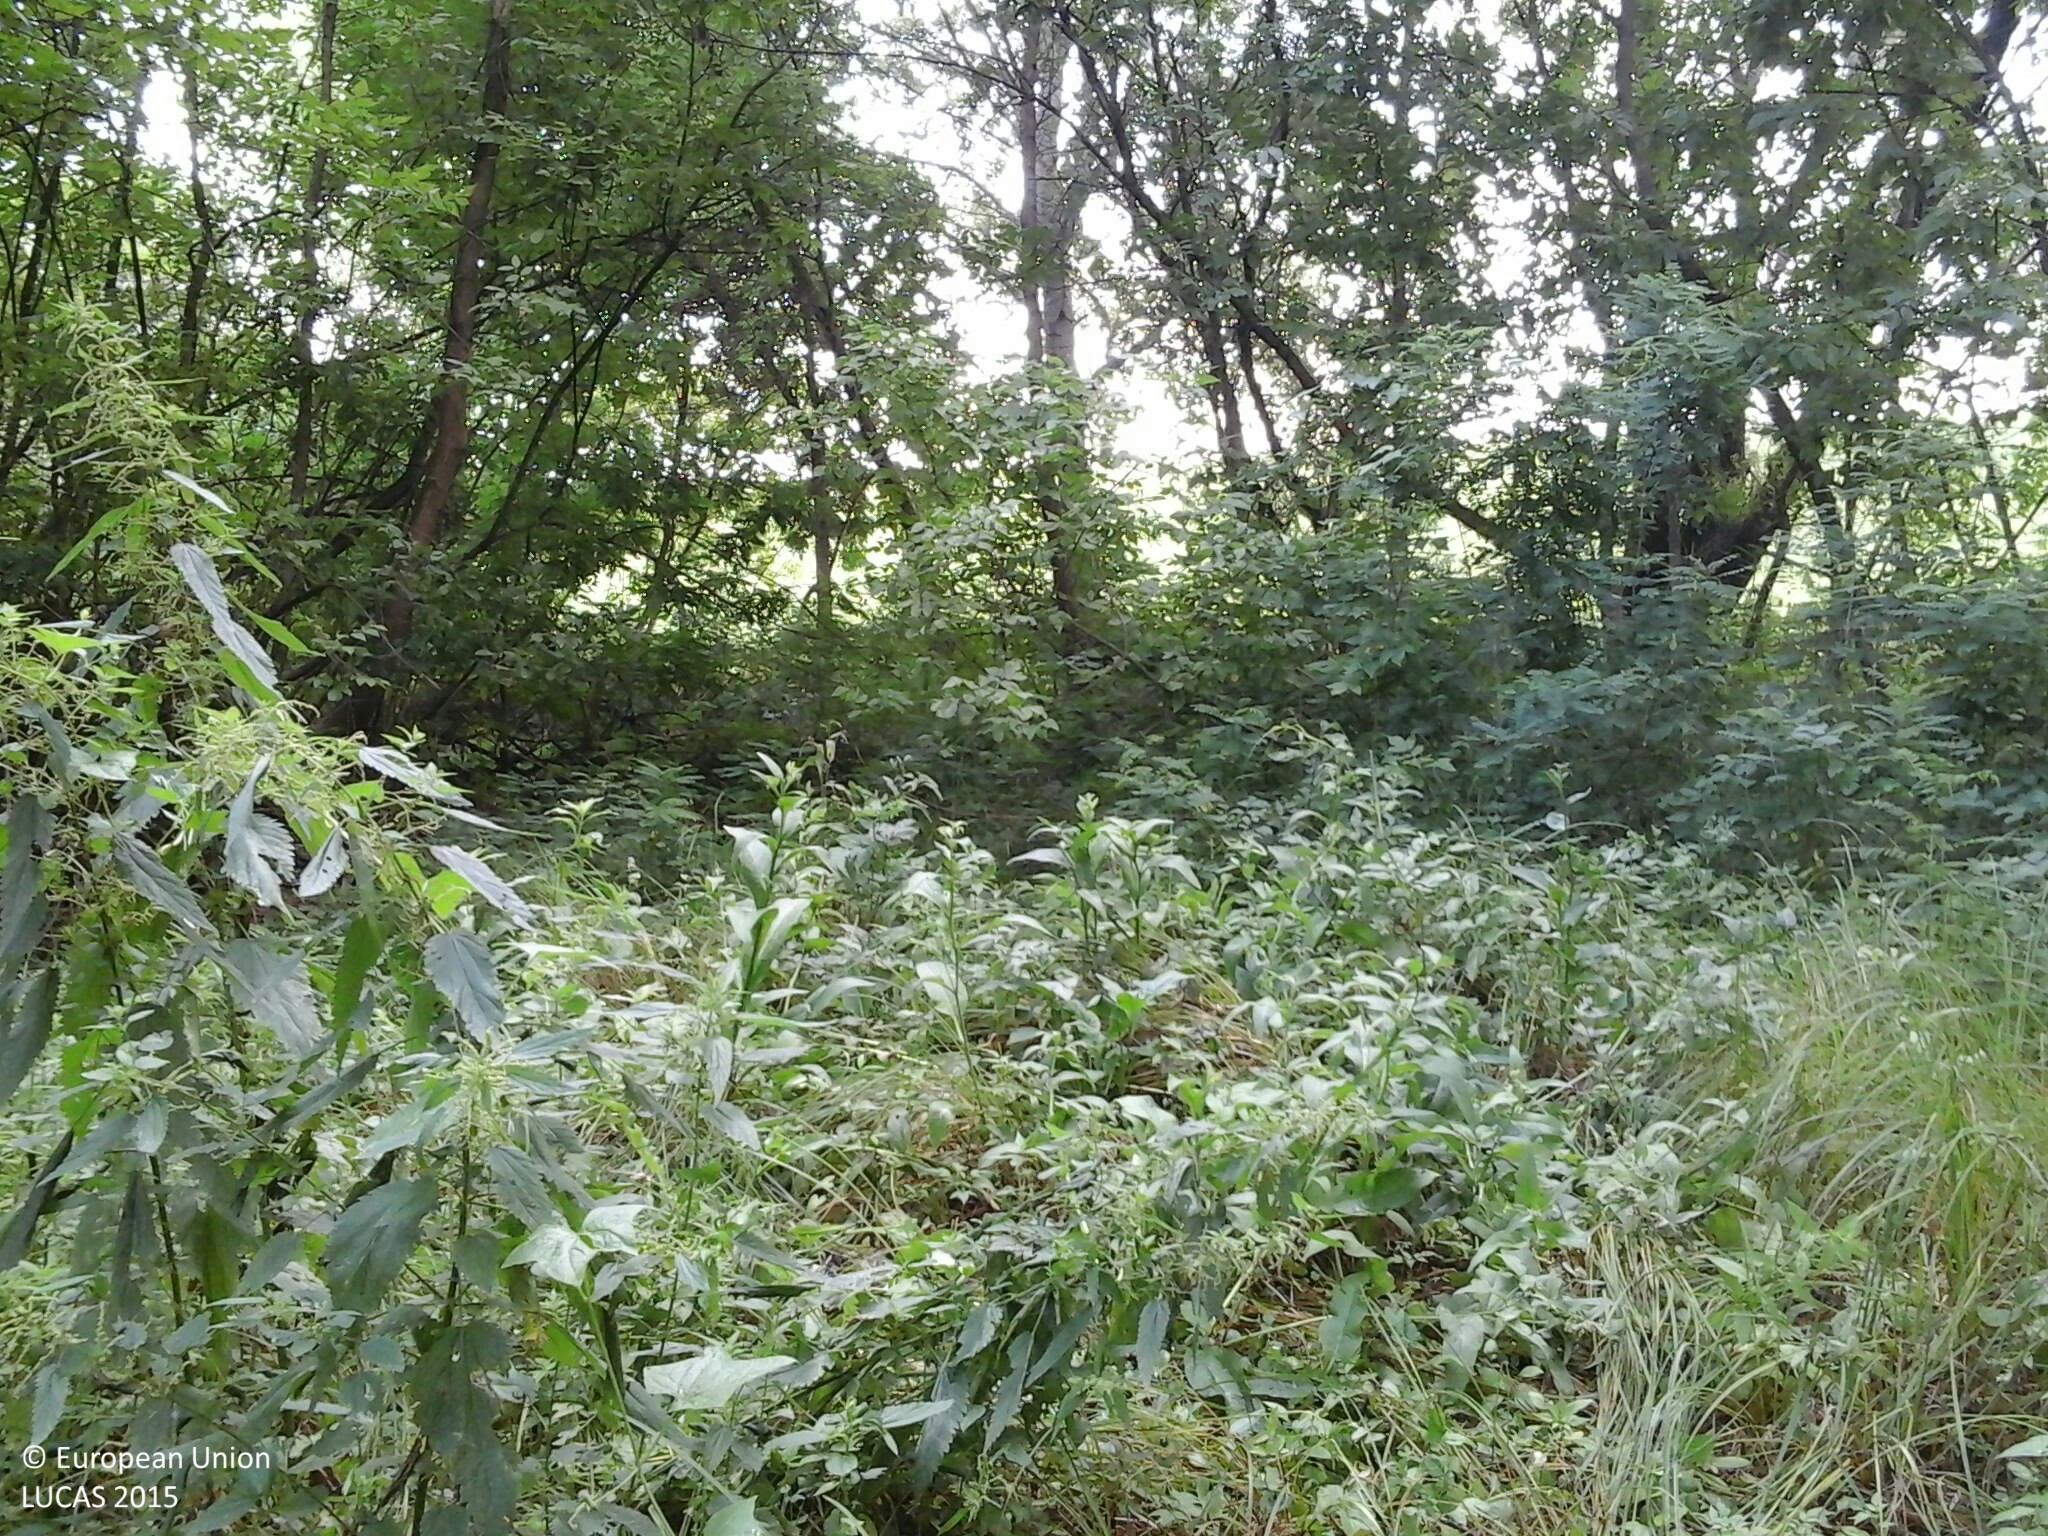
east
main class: Woodland
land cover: Broadleaved woodland
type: mesophytic deciduous forest
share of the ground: > 75 %
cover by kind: broadleaved forest trees 100 %
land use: Forestry
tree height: > 5 m
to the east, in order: Broadleaved woodland; Grassland without tree/shrub cover; Paved roads, cycling and walking lanes; Grassland without tree/shrub cover; Shrubland without tree cover; Spontaneously vegetated surfaces; Inland marshes; Spontaneously vegetated surfaces
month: July
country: HU
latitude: 47.7630
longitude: 20.9913
